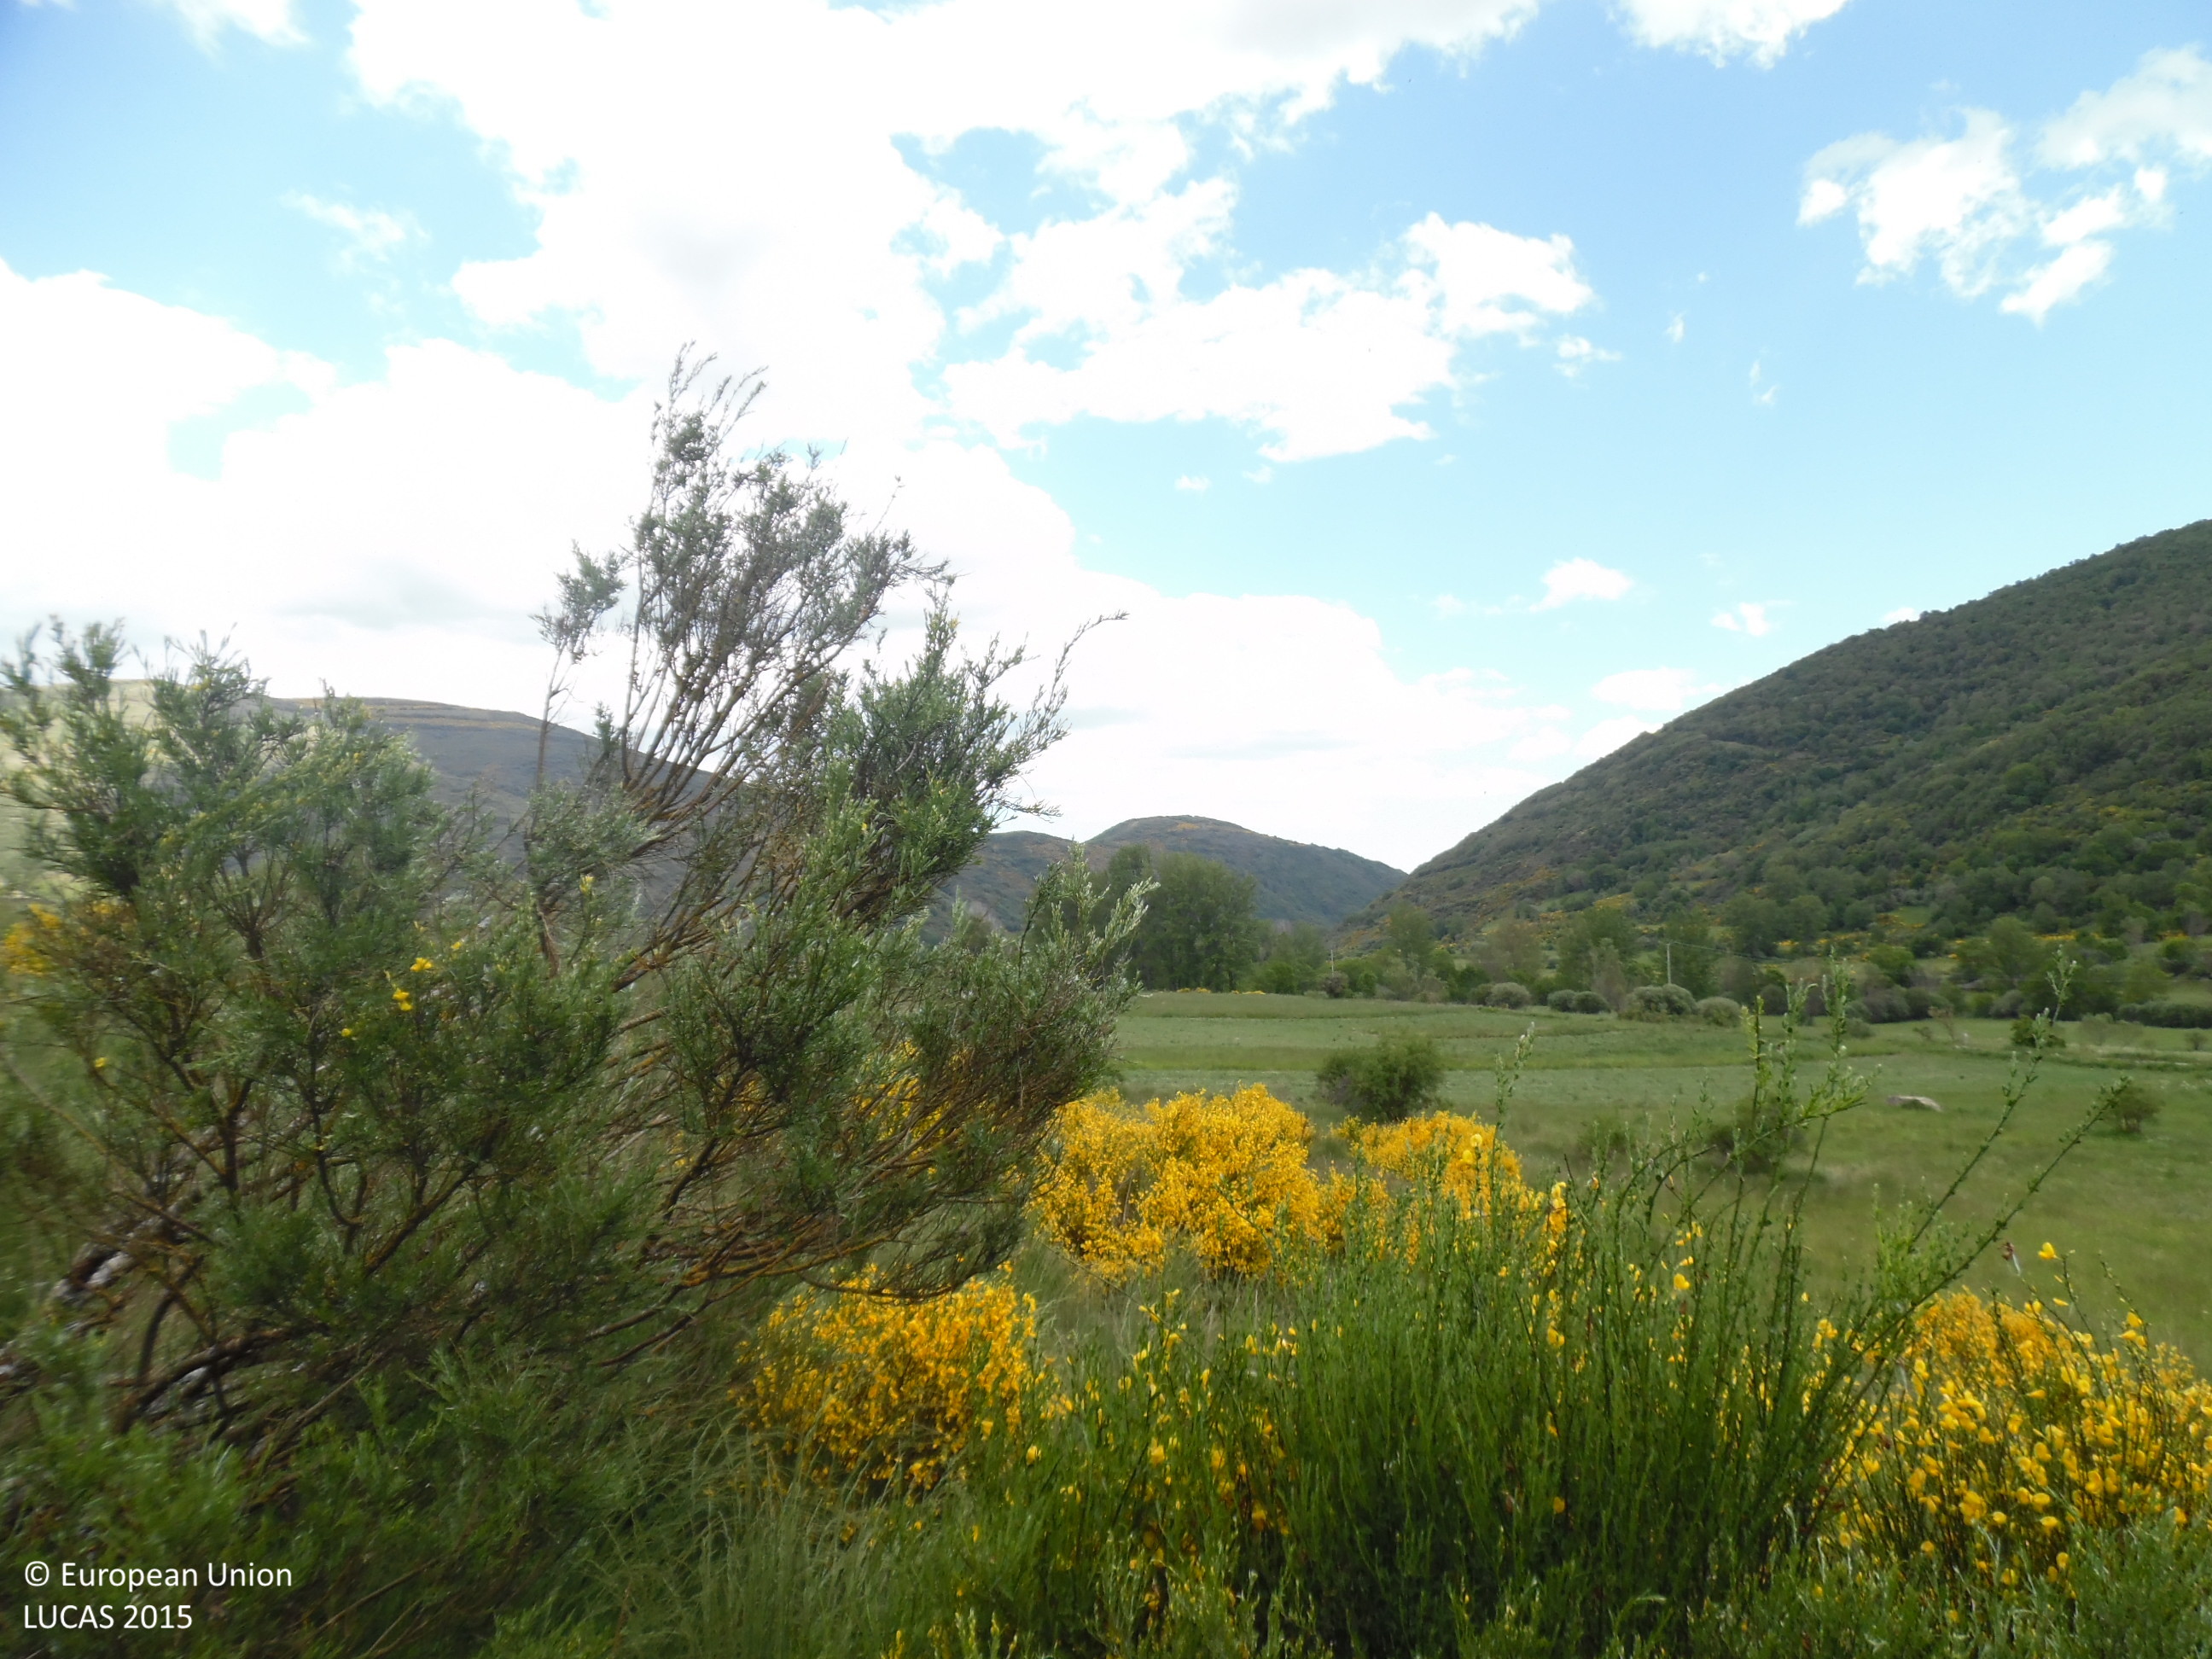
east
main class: Shrubland
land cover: Shrubland with sparse tree cover
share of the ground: 50 - 75 %
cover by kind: shrubs 85 %, herbaceous plants 10 %, coniferous forest trees 5 %
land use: Abandoned areas
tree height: < 5 m
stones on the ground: 10 - 25 %
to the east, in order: Shrubland with sparse tree cover; Grassland with sparse tree/shrub cover; Shrubland without tree cover; Spontaneously vegetated surfaces; Grassland with sparse tree/shrub cover; Spontaneously vegetated surfaces; Grassland with sparse tree/shrub cover; Fences; Grassland with sparse tree/shrub cover
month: May
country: ES
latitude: 42.8500
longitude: -6.1809
